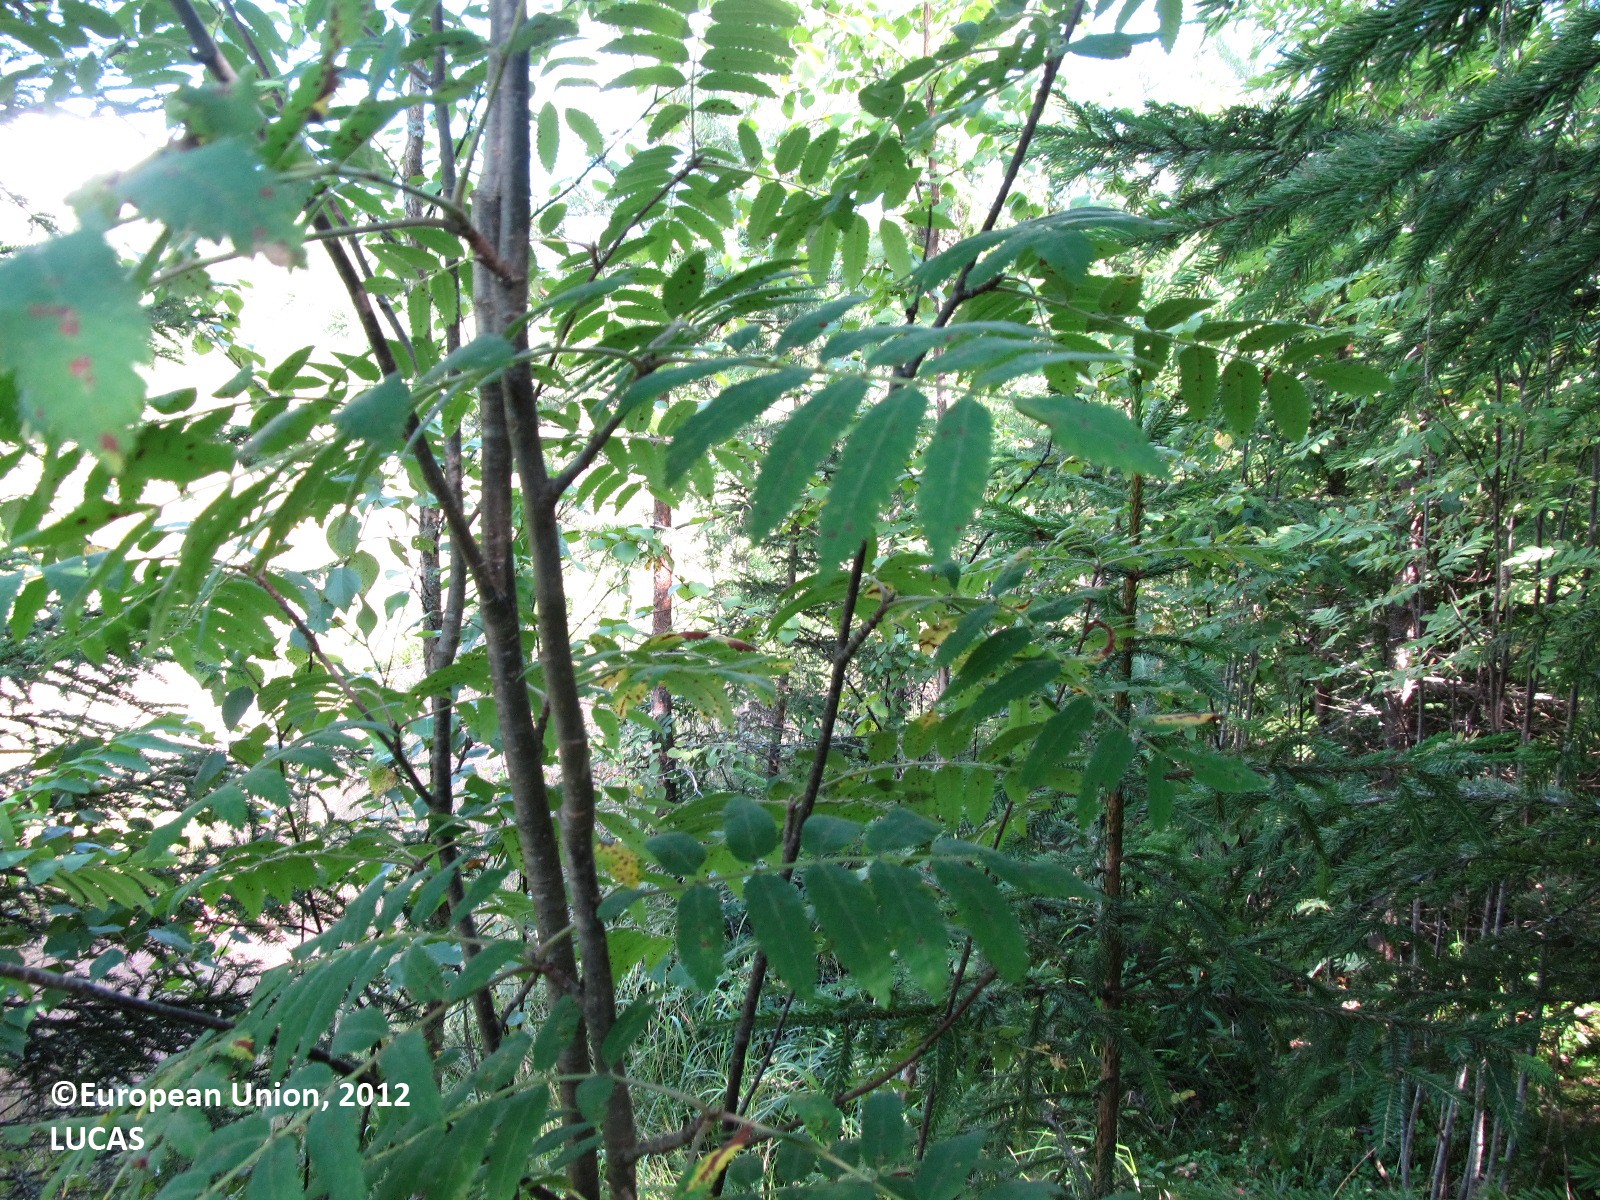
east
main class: Woodland
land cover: Spruce dominated mixed woodland
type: boreal forest
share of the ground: > 75 %
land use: Forestry
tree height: > 5 m
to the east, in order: Spruce dominated mixed woodland; Other bare soil; Ditches and canals; Other bare soil; Ditches and canals; Other bare soil; Ditches and canals; Shrubland with sparse tree cover; Broadleaved woodland
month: July
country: FI
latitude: 61.9427
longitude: 28.1277
